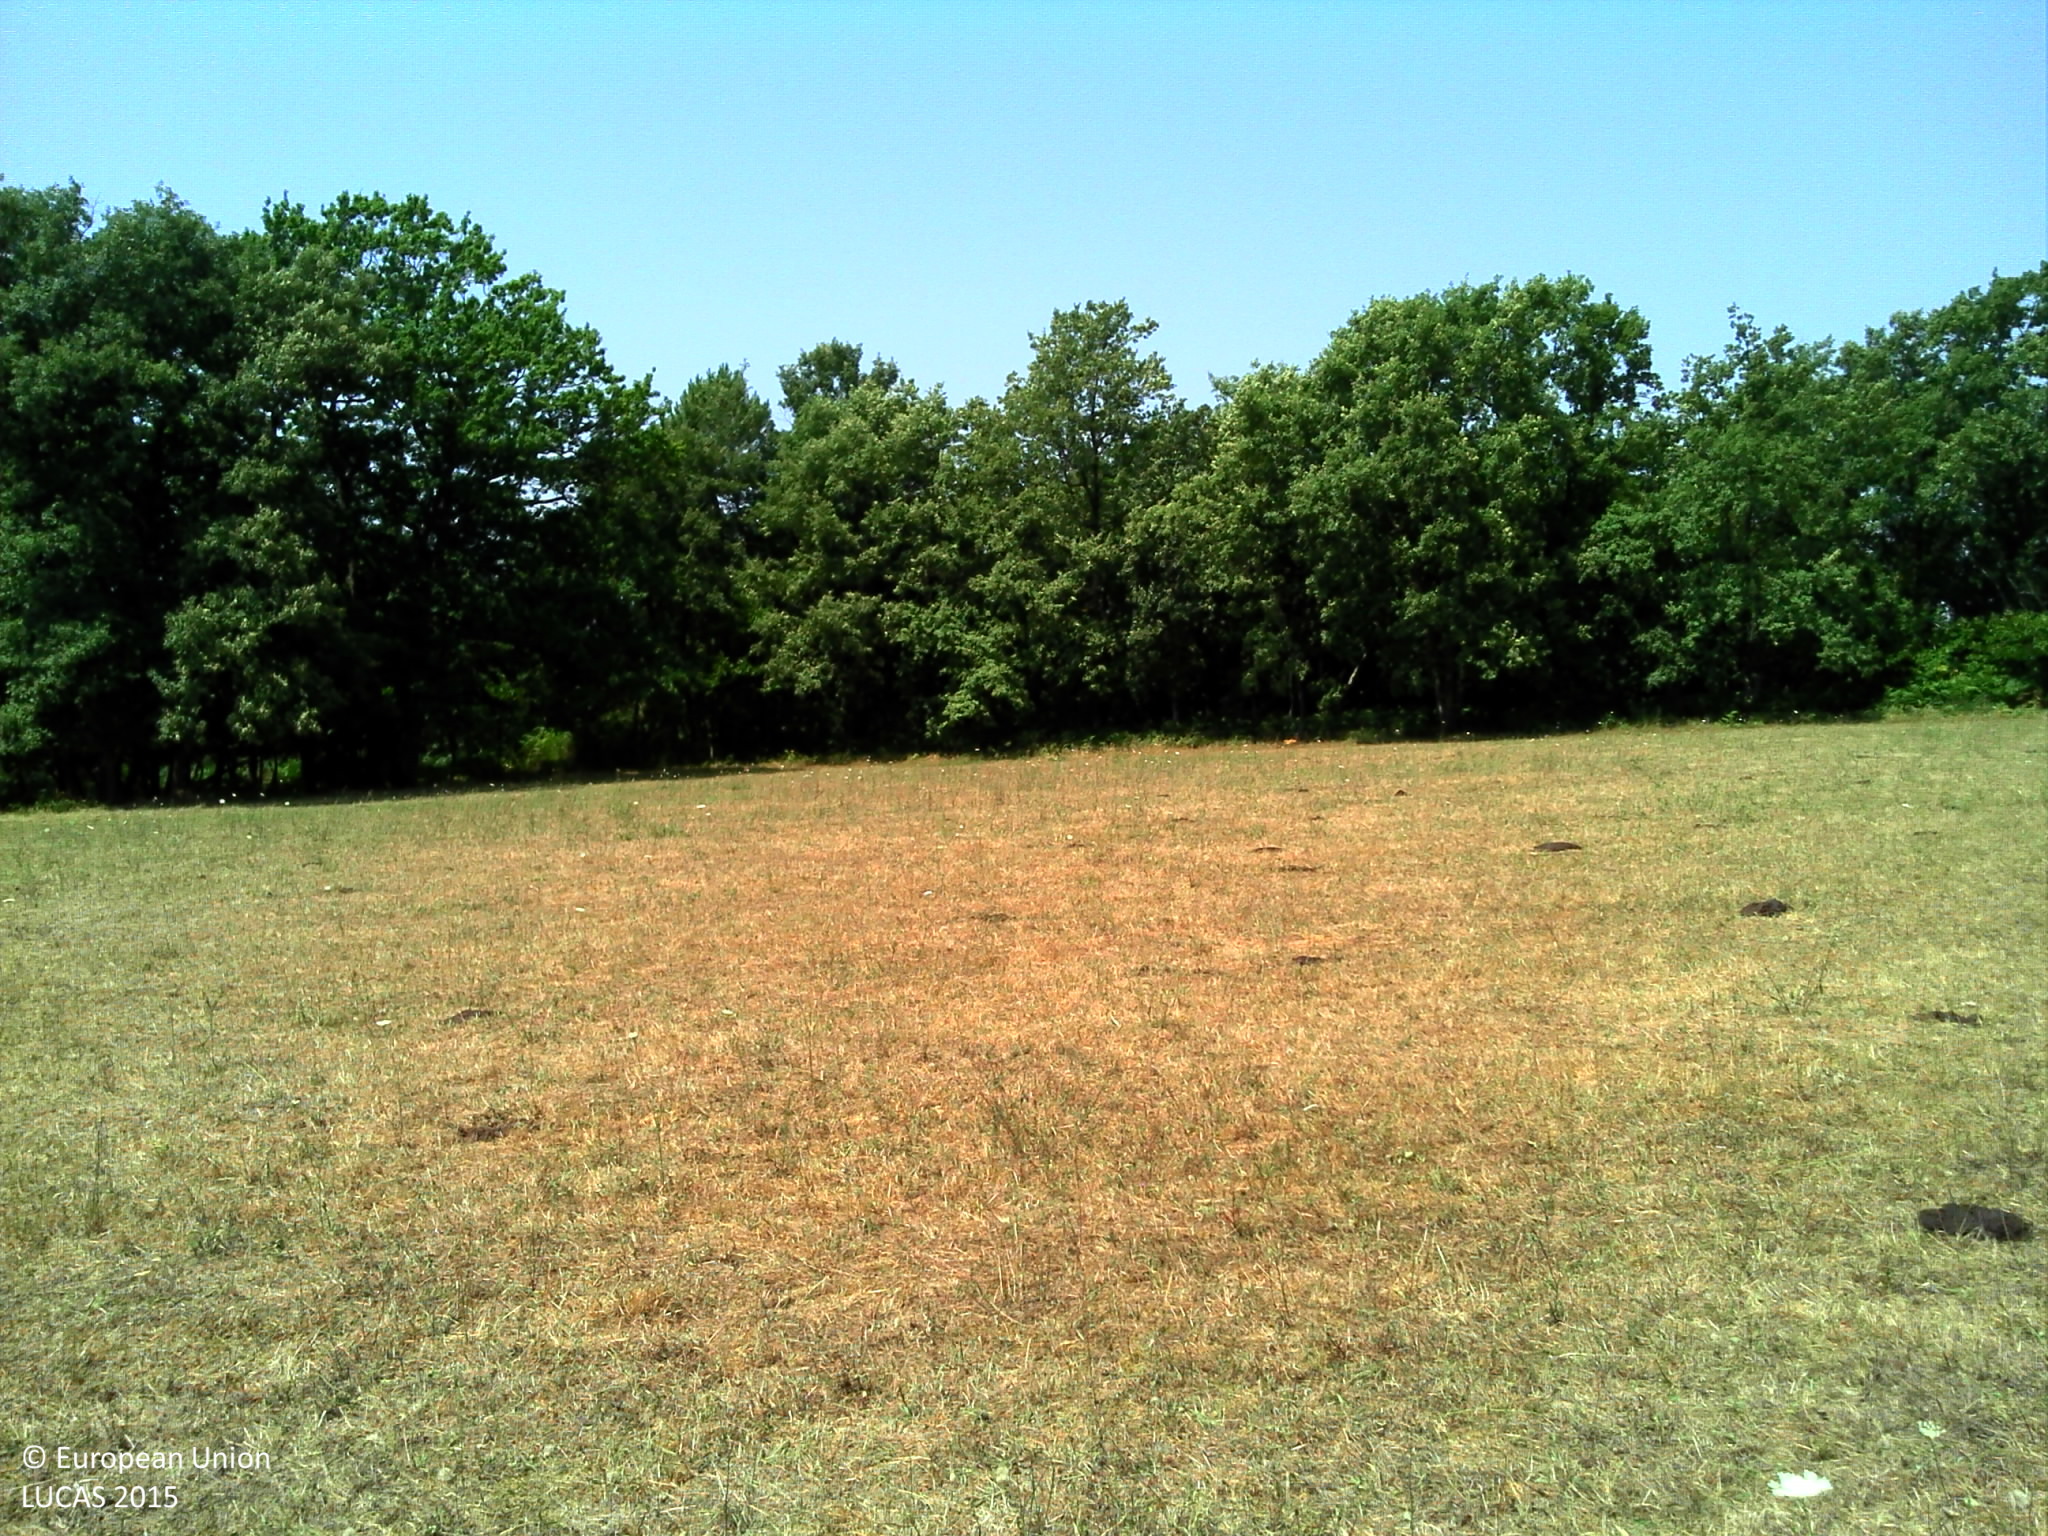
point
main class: Grassland
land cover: Grassland without tree/shrub cover
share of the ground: > 75 %
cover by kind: herbaceous plants 100 %
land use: Agriculture (excluding fallow land and kitchen gardens)
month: July
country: FR
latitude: 45.1179
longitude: 0.7747
